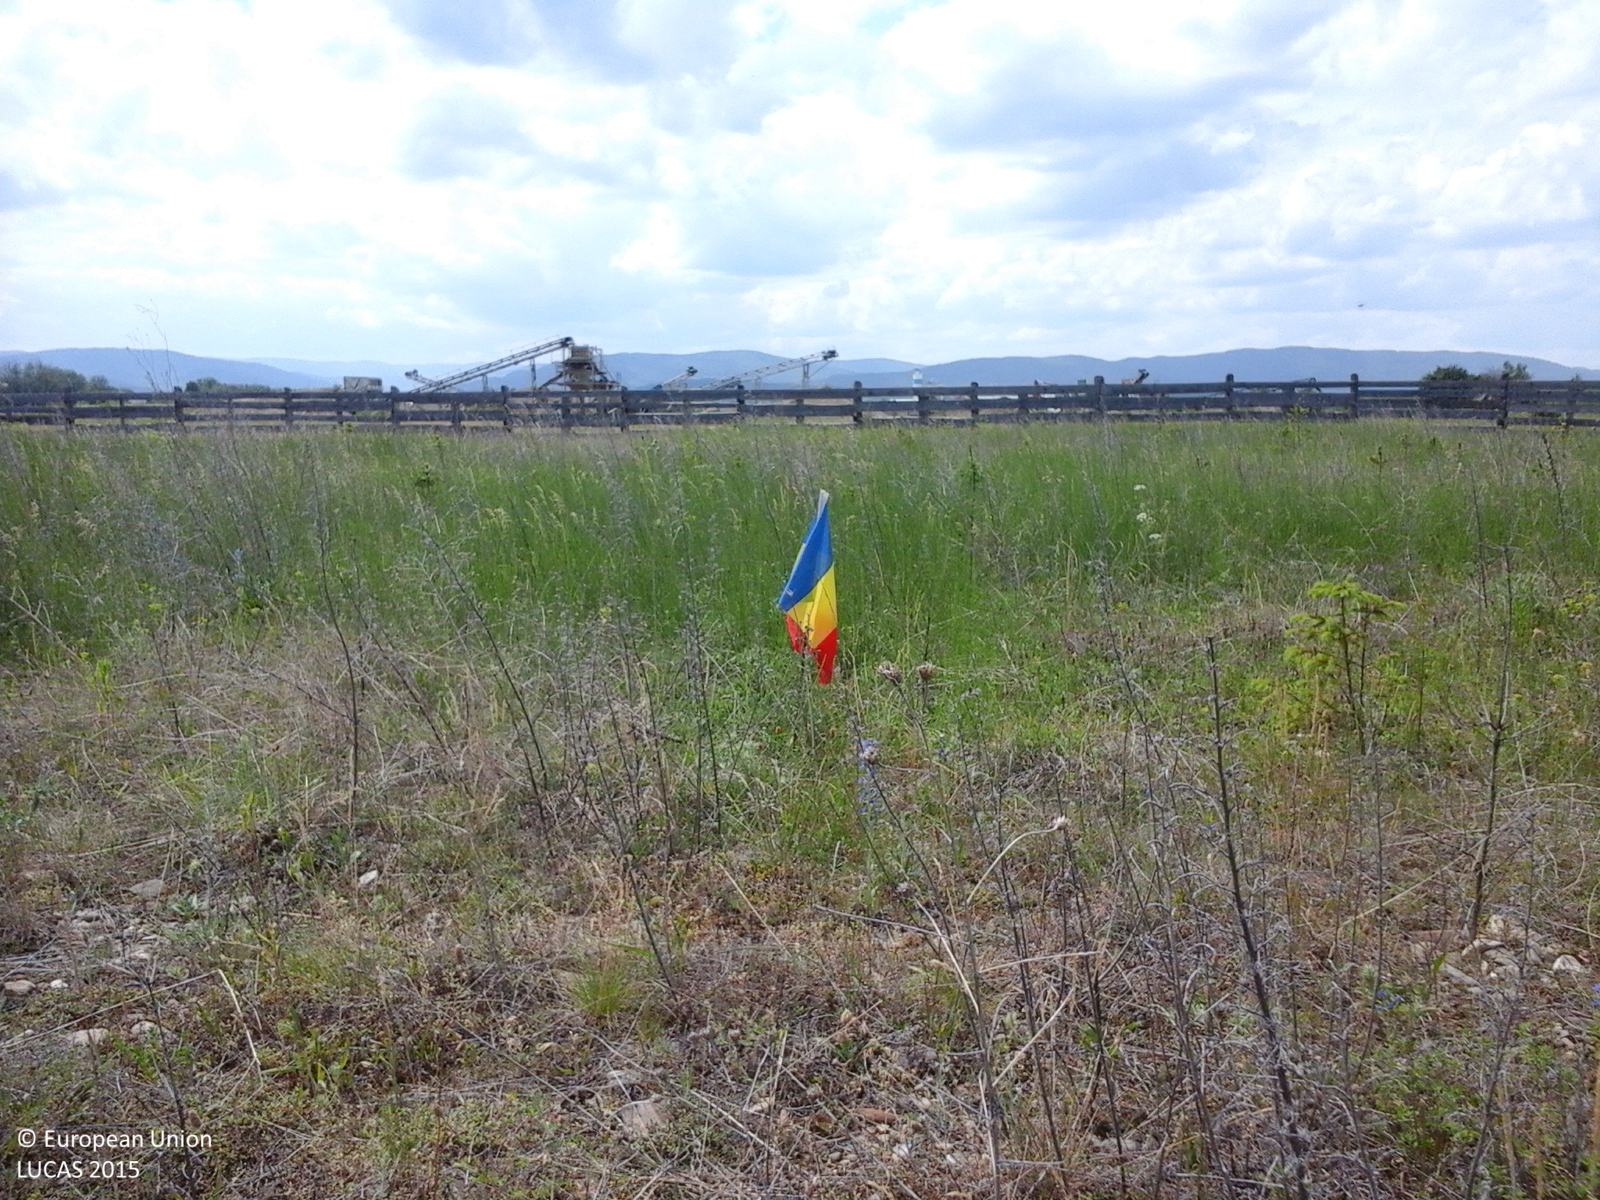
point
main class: Grassland
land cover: Spontaneously vegetated surfaces
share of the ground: > 75 %
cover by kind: herbaceous plants 100 %
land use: Fallow land
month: June
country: RO
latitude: 47.8194
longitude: 25.8472
